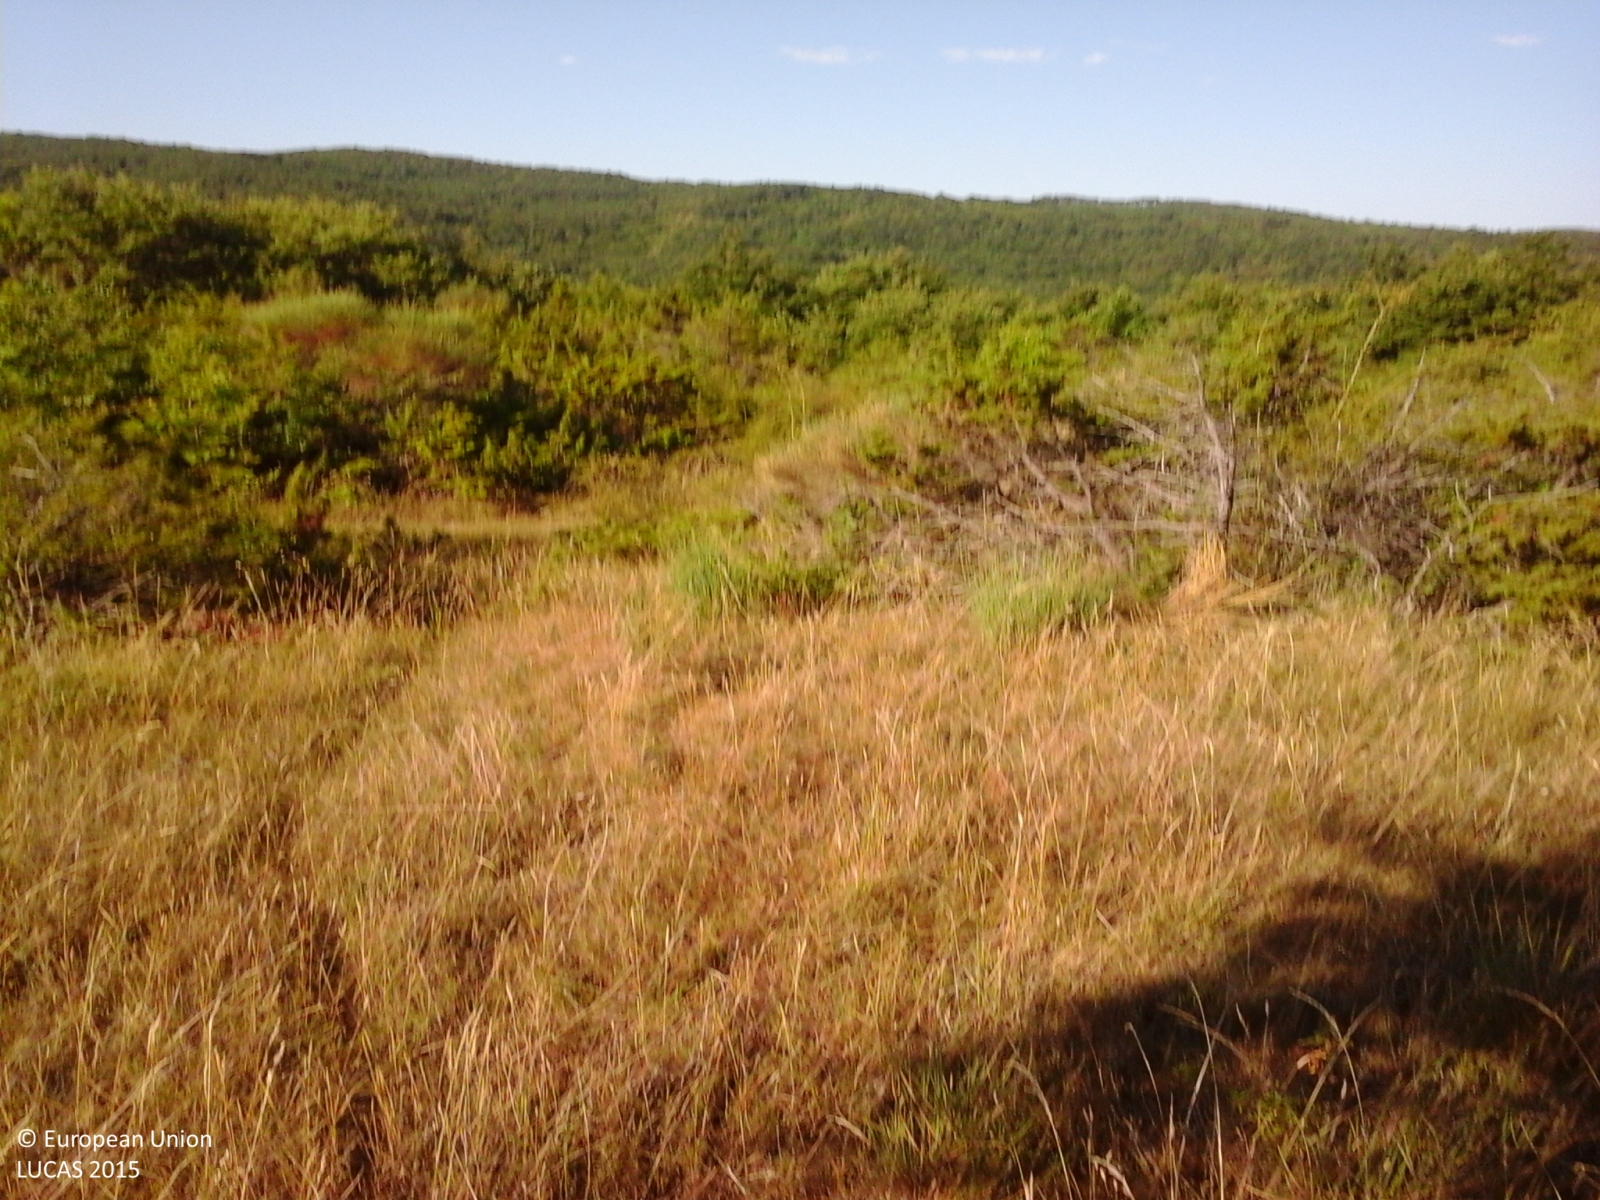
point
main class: Woodland
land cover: Broadleaved woodland
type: thermophilous deciduous forest
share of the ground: > 75 %
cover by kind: broadleaved forest trees 70 %, shrubs 20 %, herbaceous plants 10 %
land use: Semi-natural and natural areas not in use
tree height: < 5 m
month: August
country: IT
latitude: 42.9480
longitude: 11.6250
